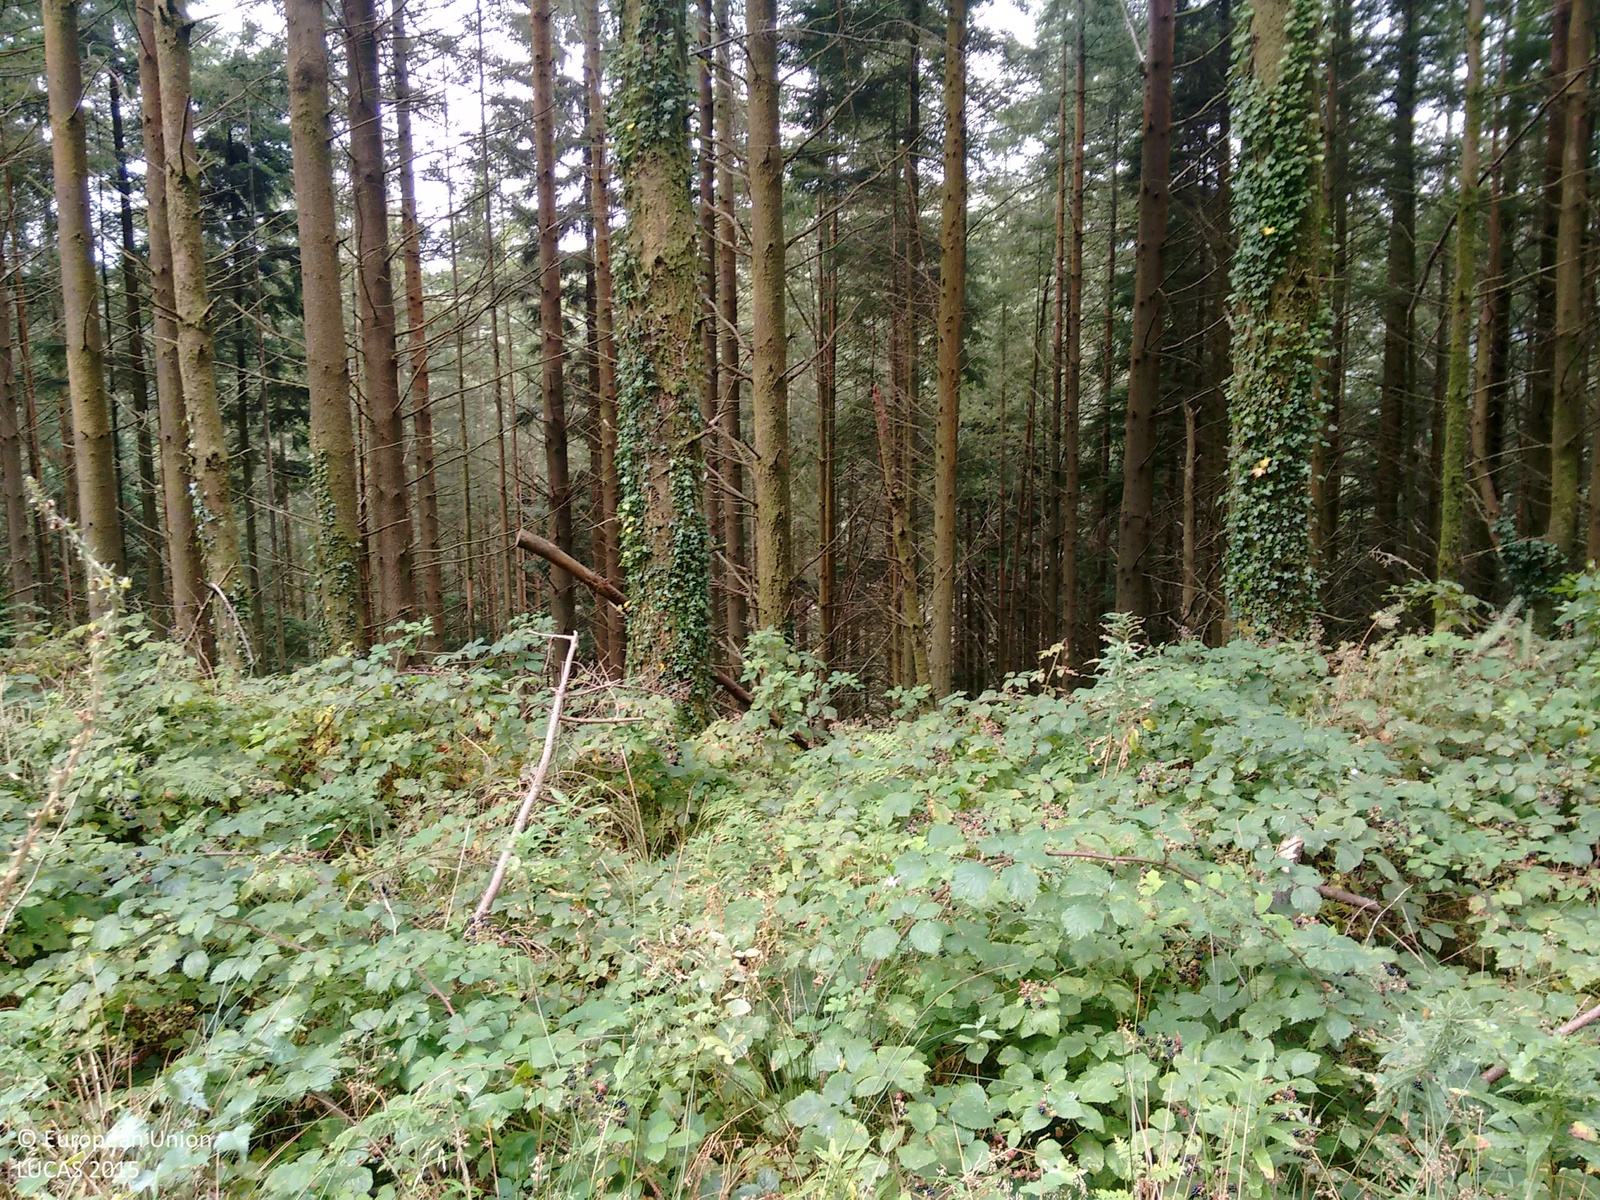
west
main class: Woodland
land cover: Other coniferous woodland
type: exotic forest
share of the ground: > 75 %
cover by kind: coniferous forest trees 100 %
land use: Forestry
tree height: > 5 m
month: September
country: GB
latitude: 52.6897
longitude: -3.7144
